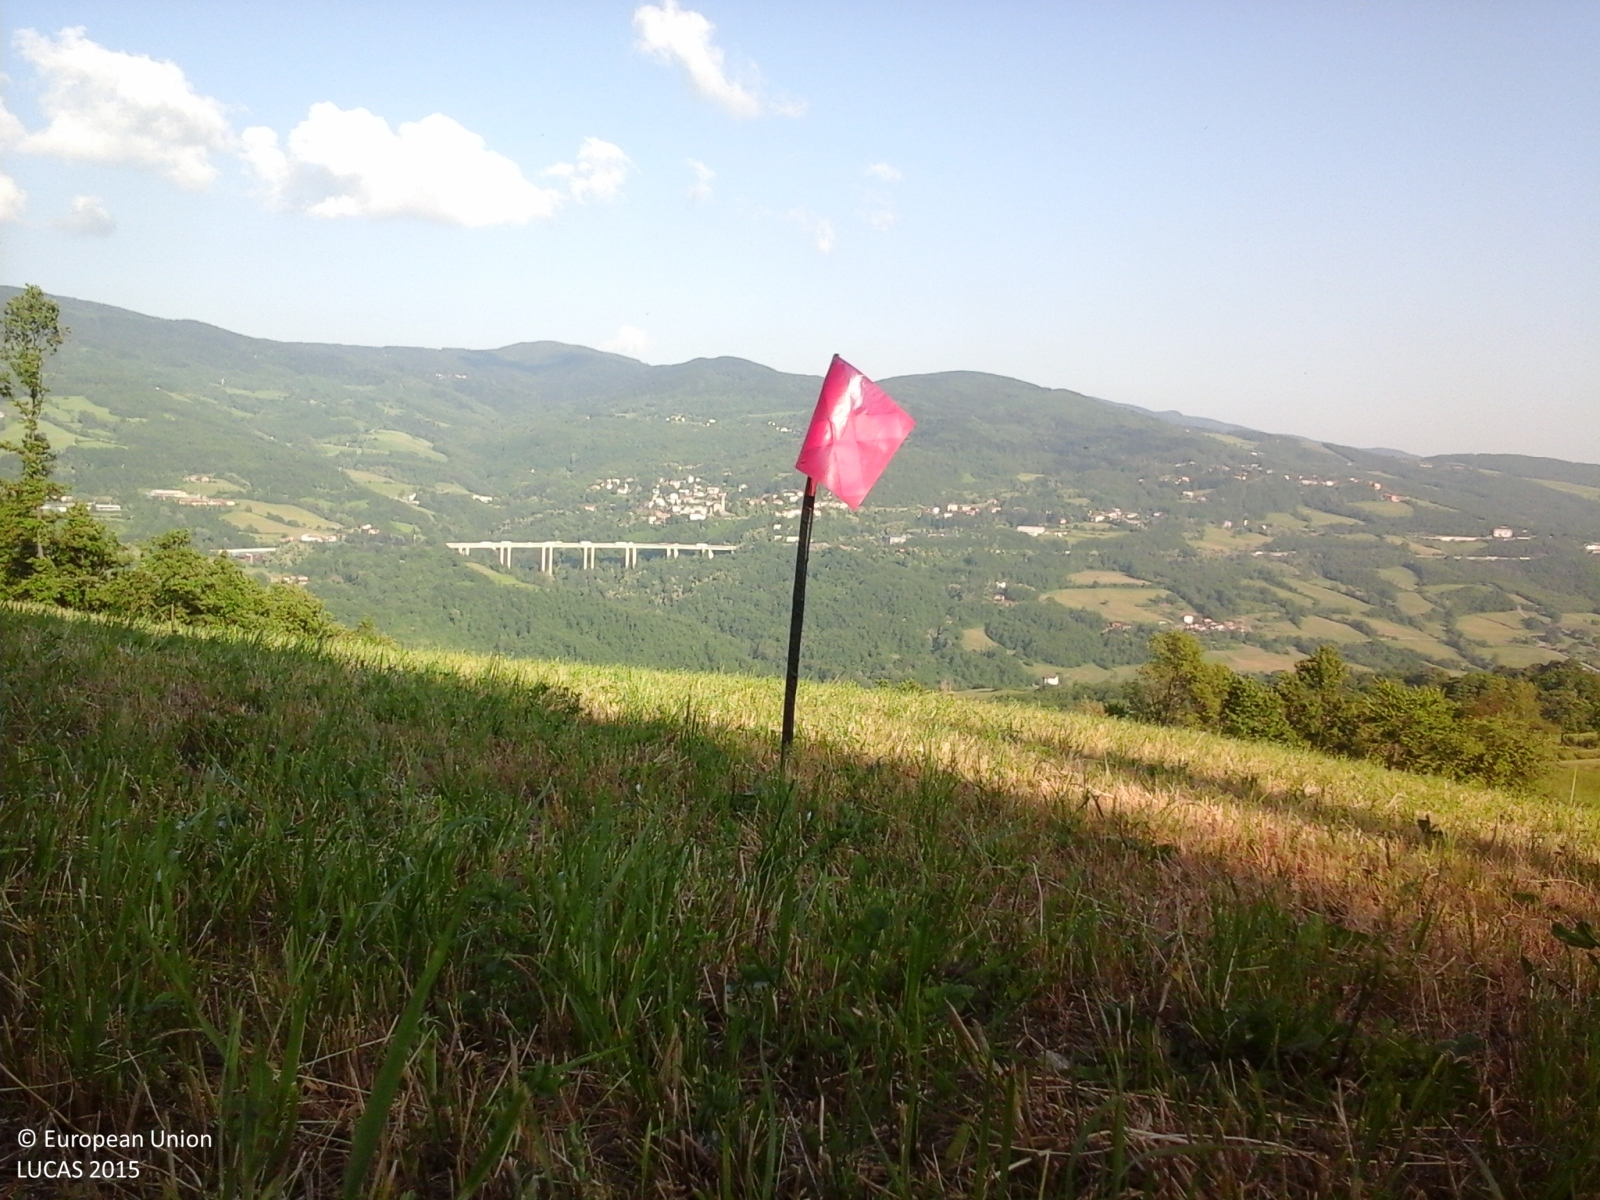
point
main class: Grassland
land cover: Grassland without tree/shrub cover
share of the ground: > 75 %
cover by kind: herbaceous plants 100 %
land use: Agriculture (excluding fallow land and kitchen gardens)
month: May
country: IT
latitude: 44.1814
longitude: 11.1855
